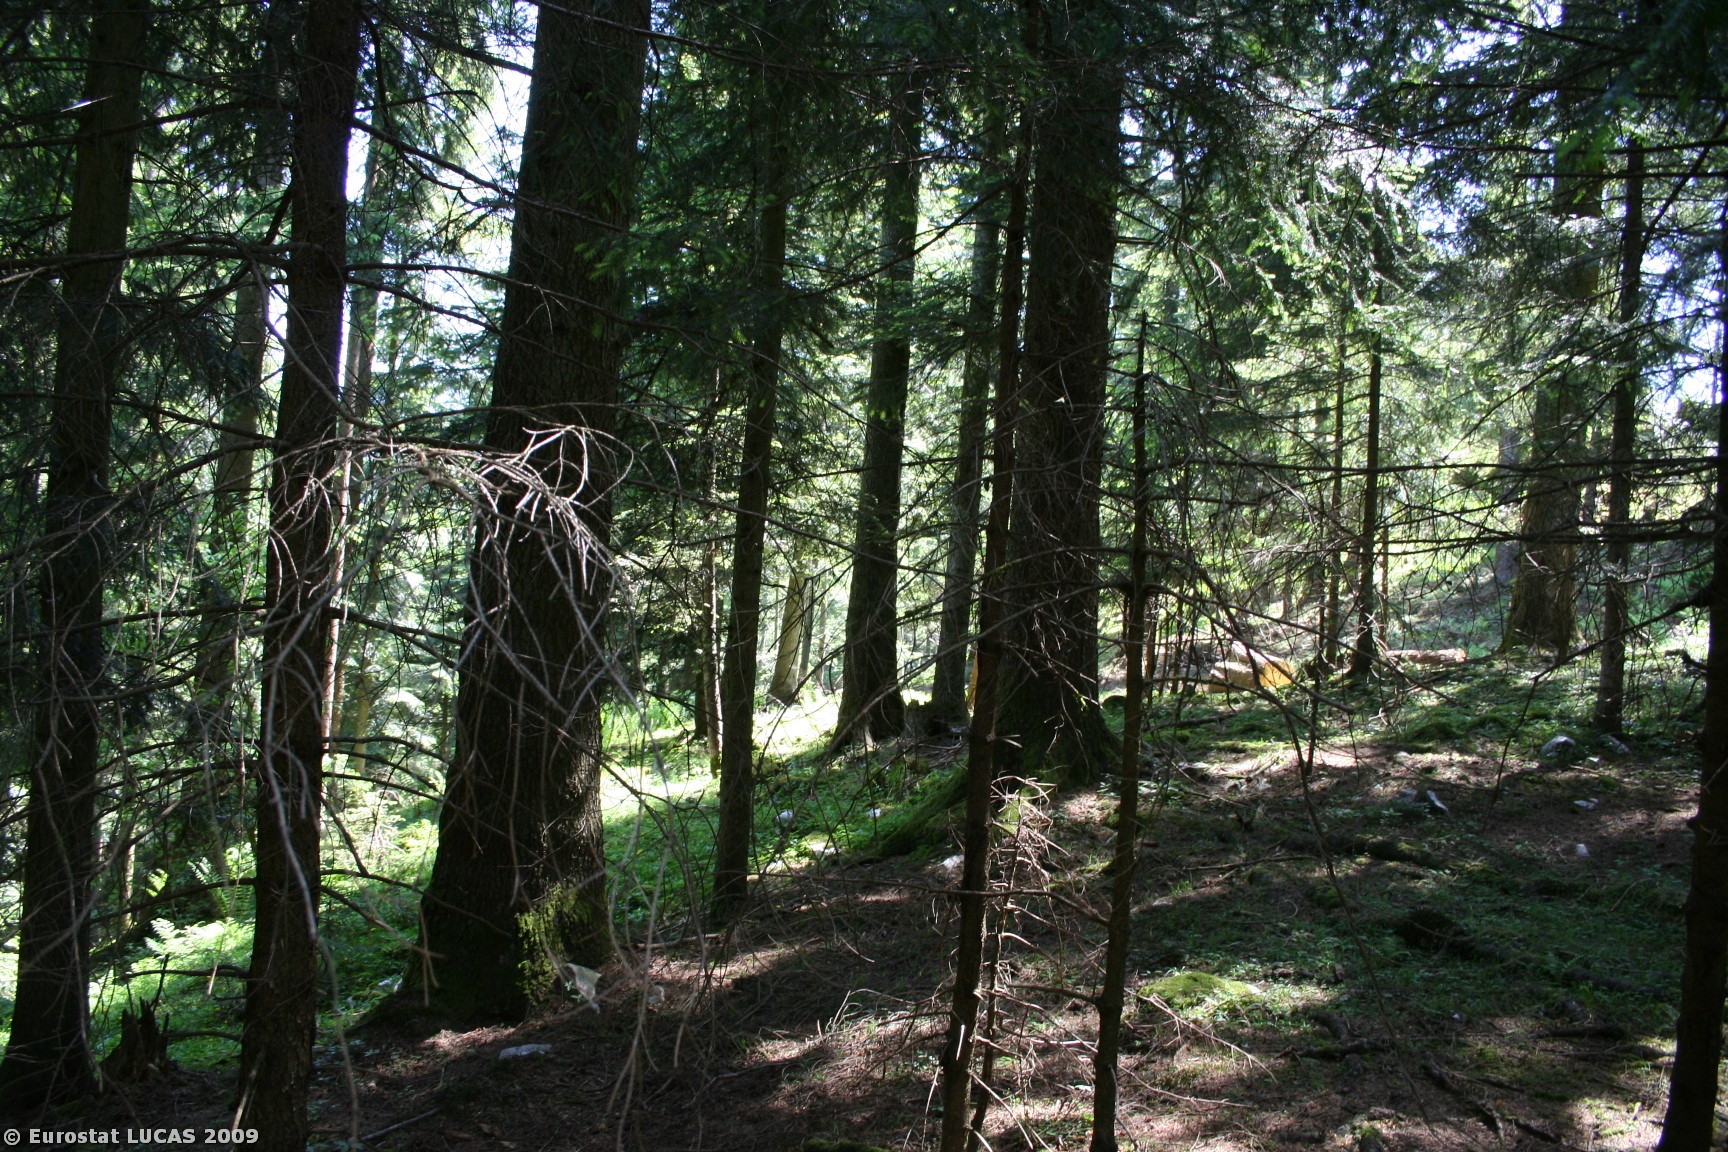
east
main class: Woodland
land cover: Coniferous woodland
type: alpine coniferous forest
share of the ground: > 75 %
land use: Forestry
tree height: > 5 m
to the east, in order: Coniferous woodland; Tracks; Coniferous woodland; Shrubland with sparse tree cover; Coniferous woodland
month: May
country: AT
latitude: 47.6546
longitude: 13.2072
